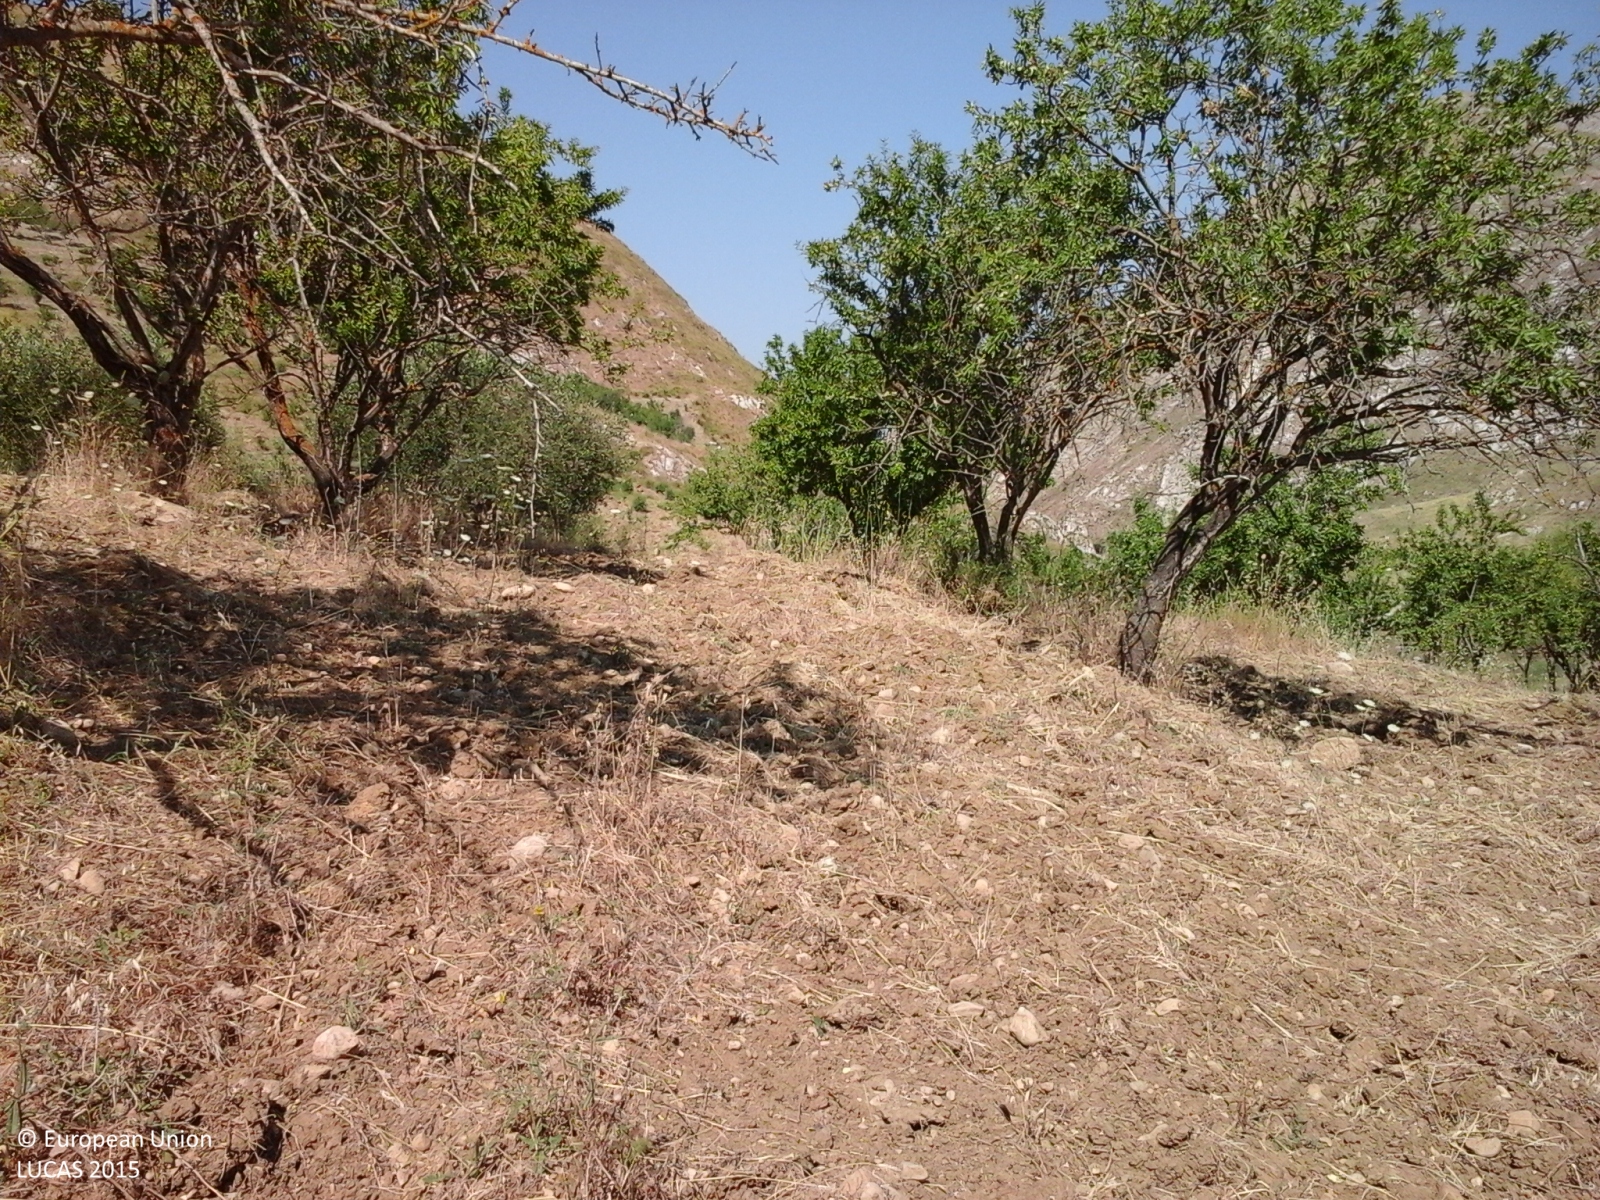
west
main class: Cropland
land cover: Nuts trees
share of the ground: 25 - 50 %
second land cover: Spontaneously vegetated surfaces
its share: > 75 %
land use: Agriculture (excluding fallow land and kitchen gardens)
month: July
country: IT
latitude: 37.4473
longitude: 13.4886
